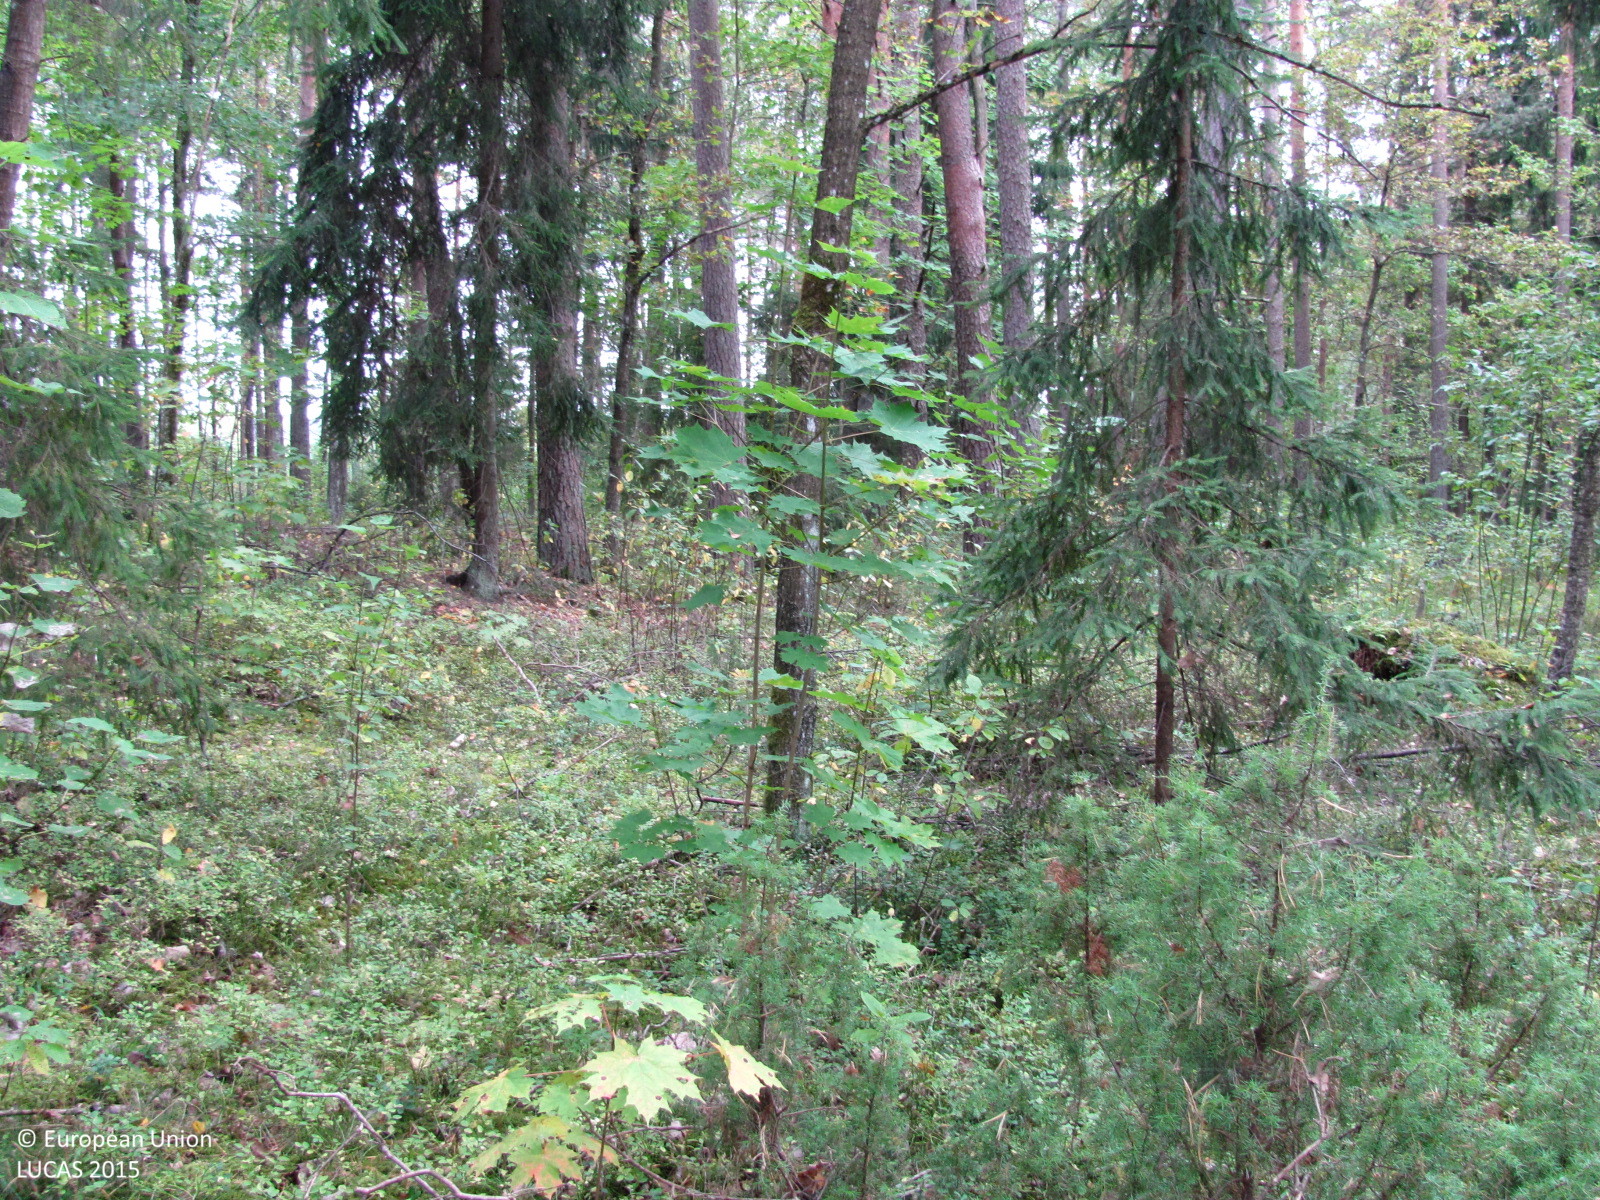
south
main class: Woodland
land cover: Other mixed woodland
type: hemiboreal forest and nemoral coniferous forest and mixed broadleaved-coniferous forest
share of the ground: > 75 %
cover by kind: broadleaved forest trees 55 %, coniferous forest trees 25 %, herbaceous plants 10 %, lichens and mosses 10 %
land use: Forestry
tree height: > 5 m
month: September
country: LV
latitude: 57.1110
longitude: 24.5419
